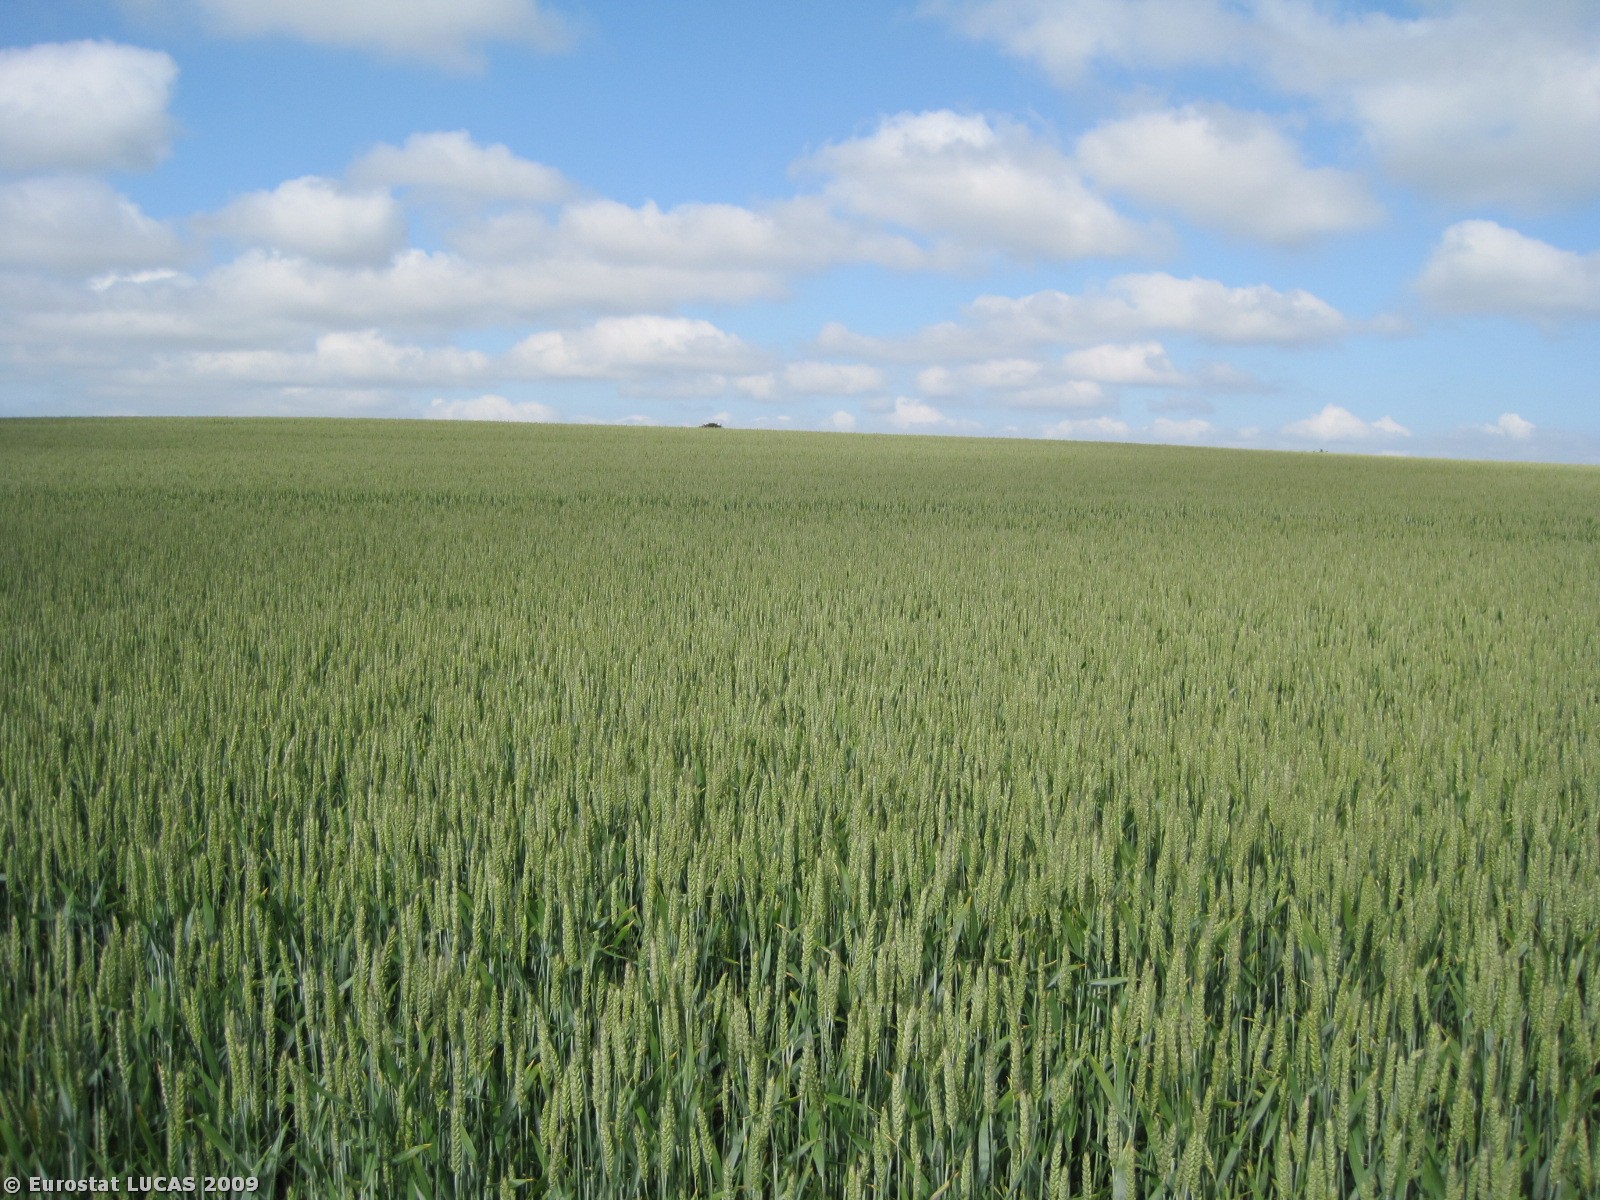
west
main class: Cropland
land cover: Common wheat
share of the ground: > 75 %
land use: Agriculture (excluding fallow land and kitchen gardens)
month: June
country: DK
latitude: 56.7749
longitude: 8.7417
